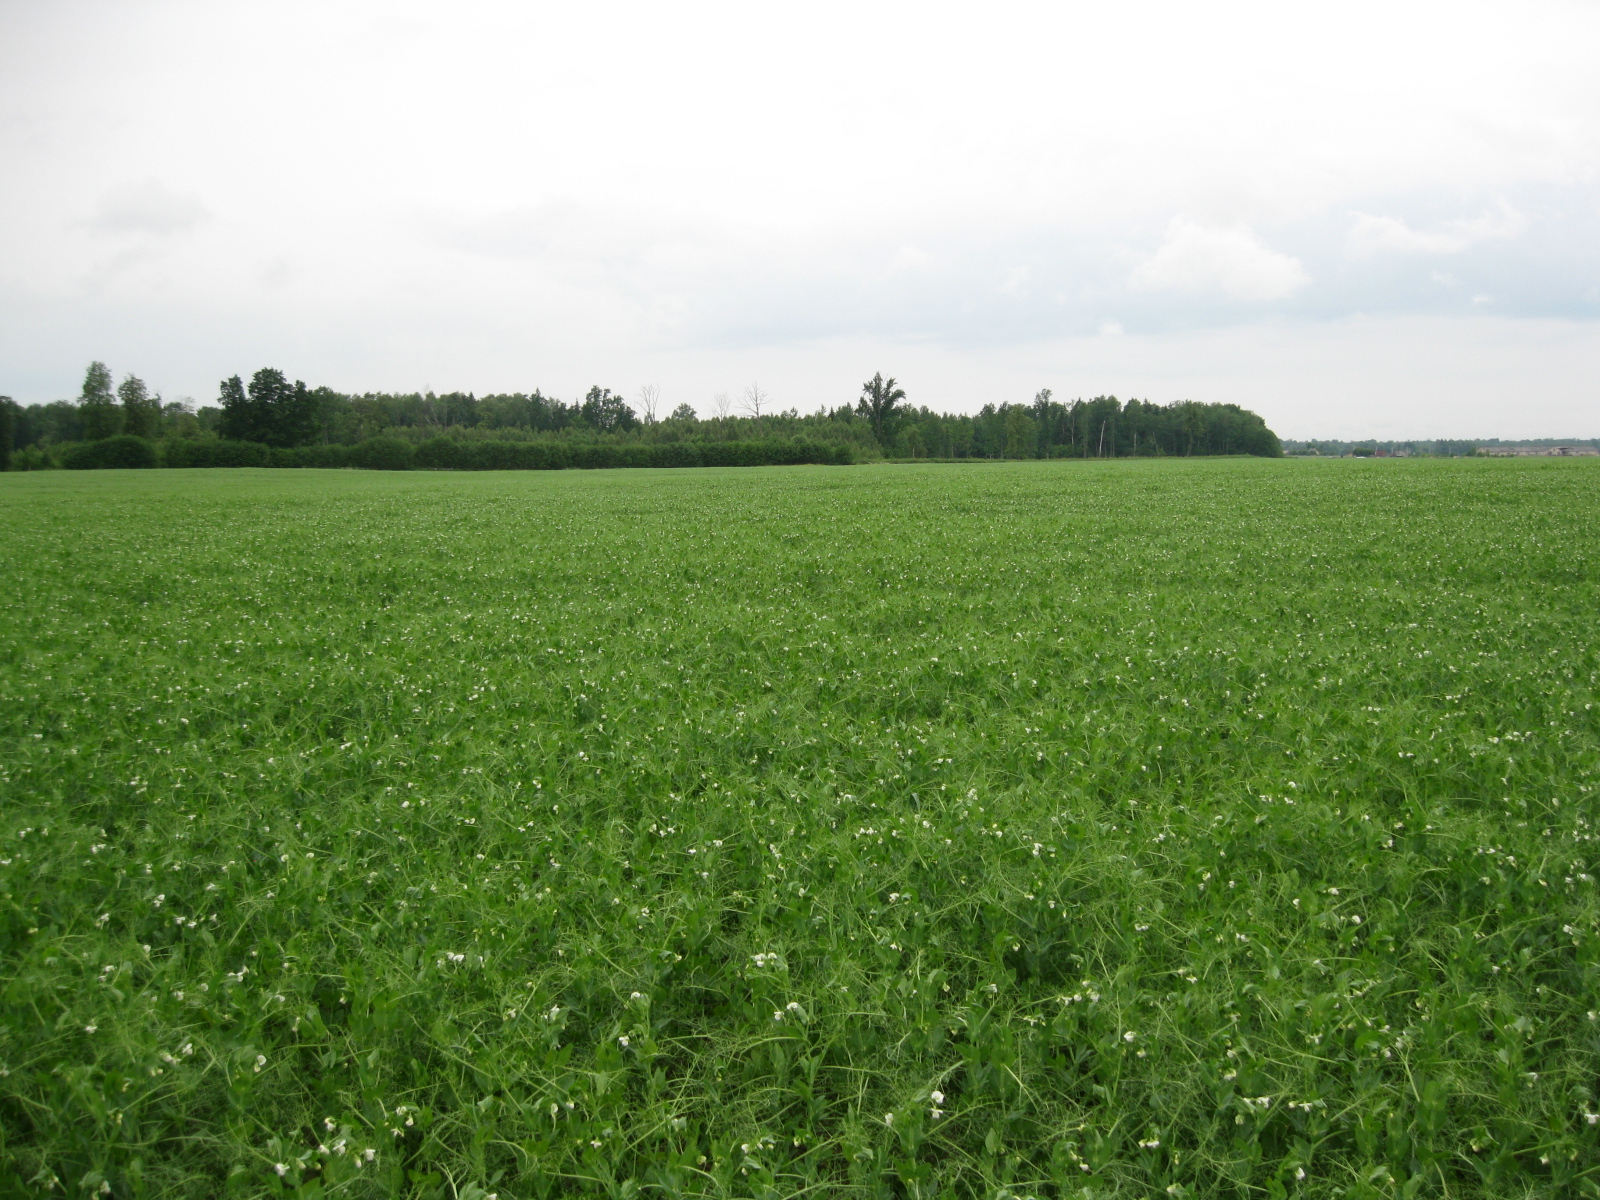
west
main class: Cropland
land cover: Dry pulses
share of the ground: > 75 %
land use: Agriculture (excluding fallow land and kitchen gardens)
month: June
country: LT
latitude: 55.1157
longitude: 24.0610
